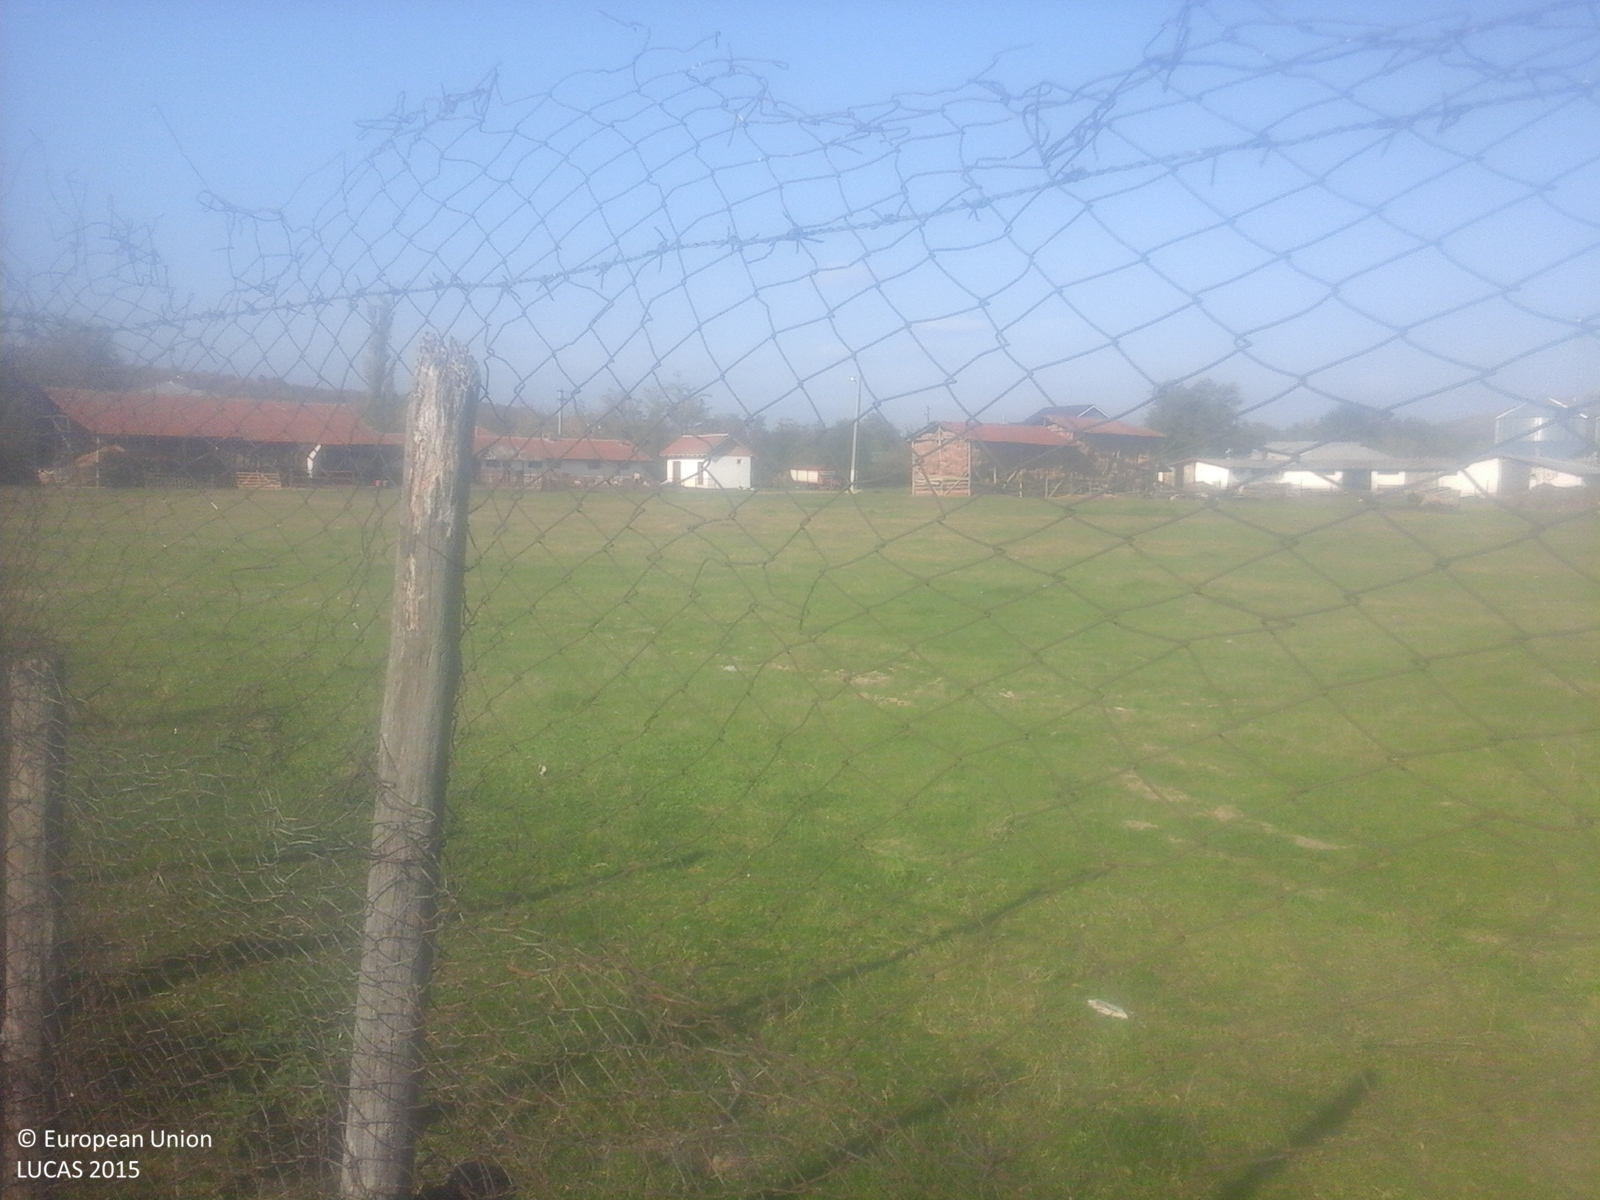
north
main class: Grassland
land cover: Grassland without tree/shrub cover
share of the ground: > 75 %
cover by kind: herbaceous plants 100 %
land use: Agriculture (excluding fallow land and kitchen gardens)
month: October
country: RO
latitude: 45.2921
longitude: 26.8754
